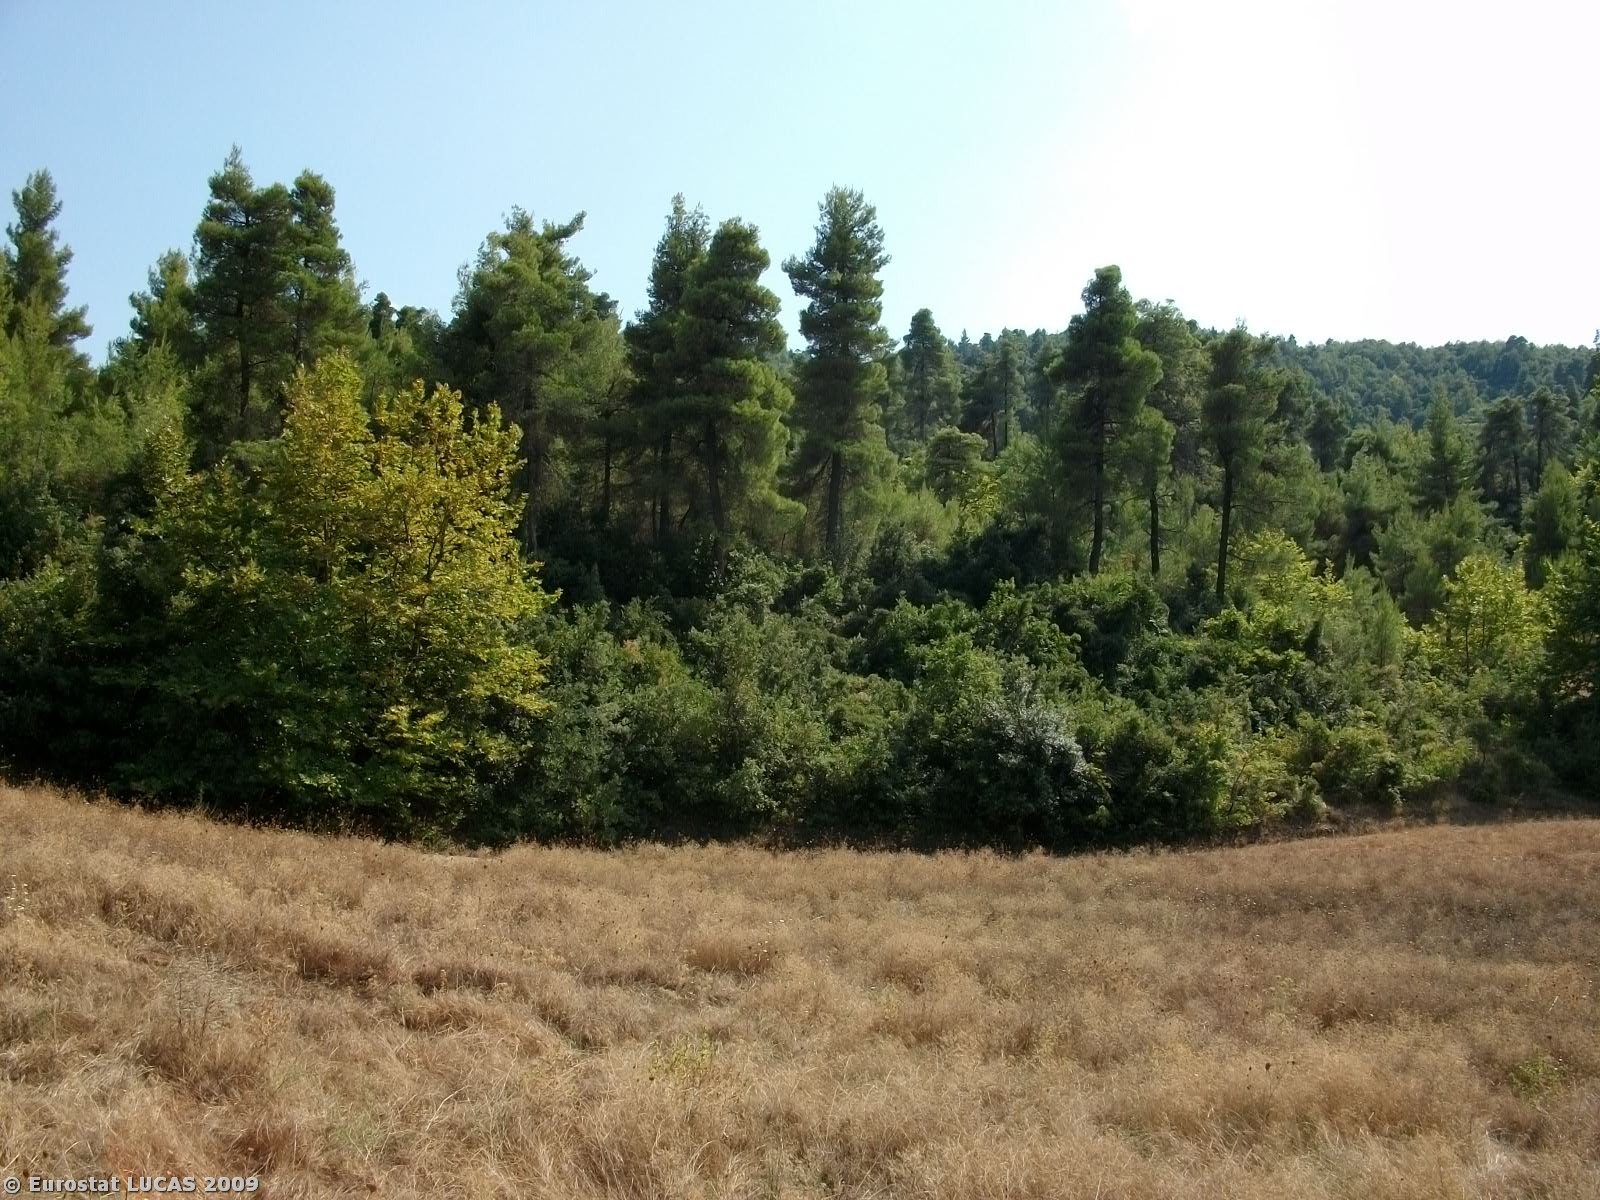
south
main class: Shrubland
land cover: Shrubland without tree cover
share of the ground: 25 - 50 %
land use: Fallow land
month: August
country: GR
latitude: 38.8995
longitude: 23.1668
